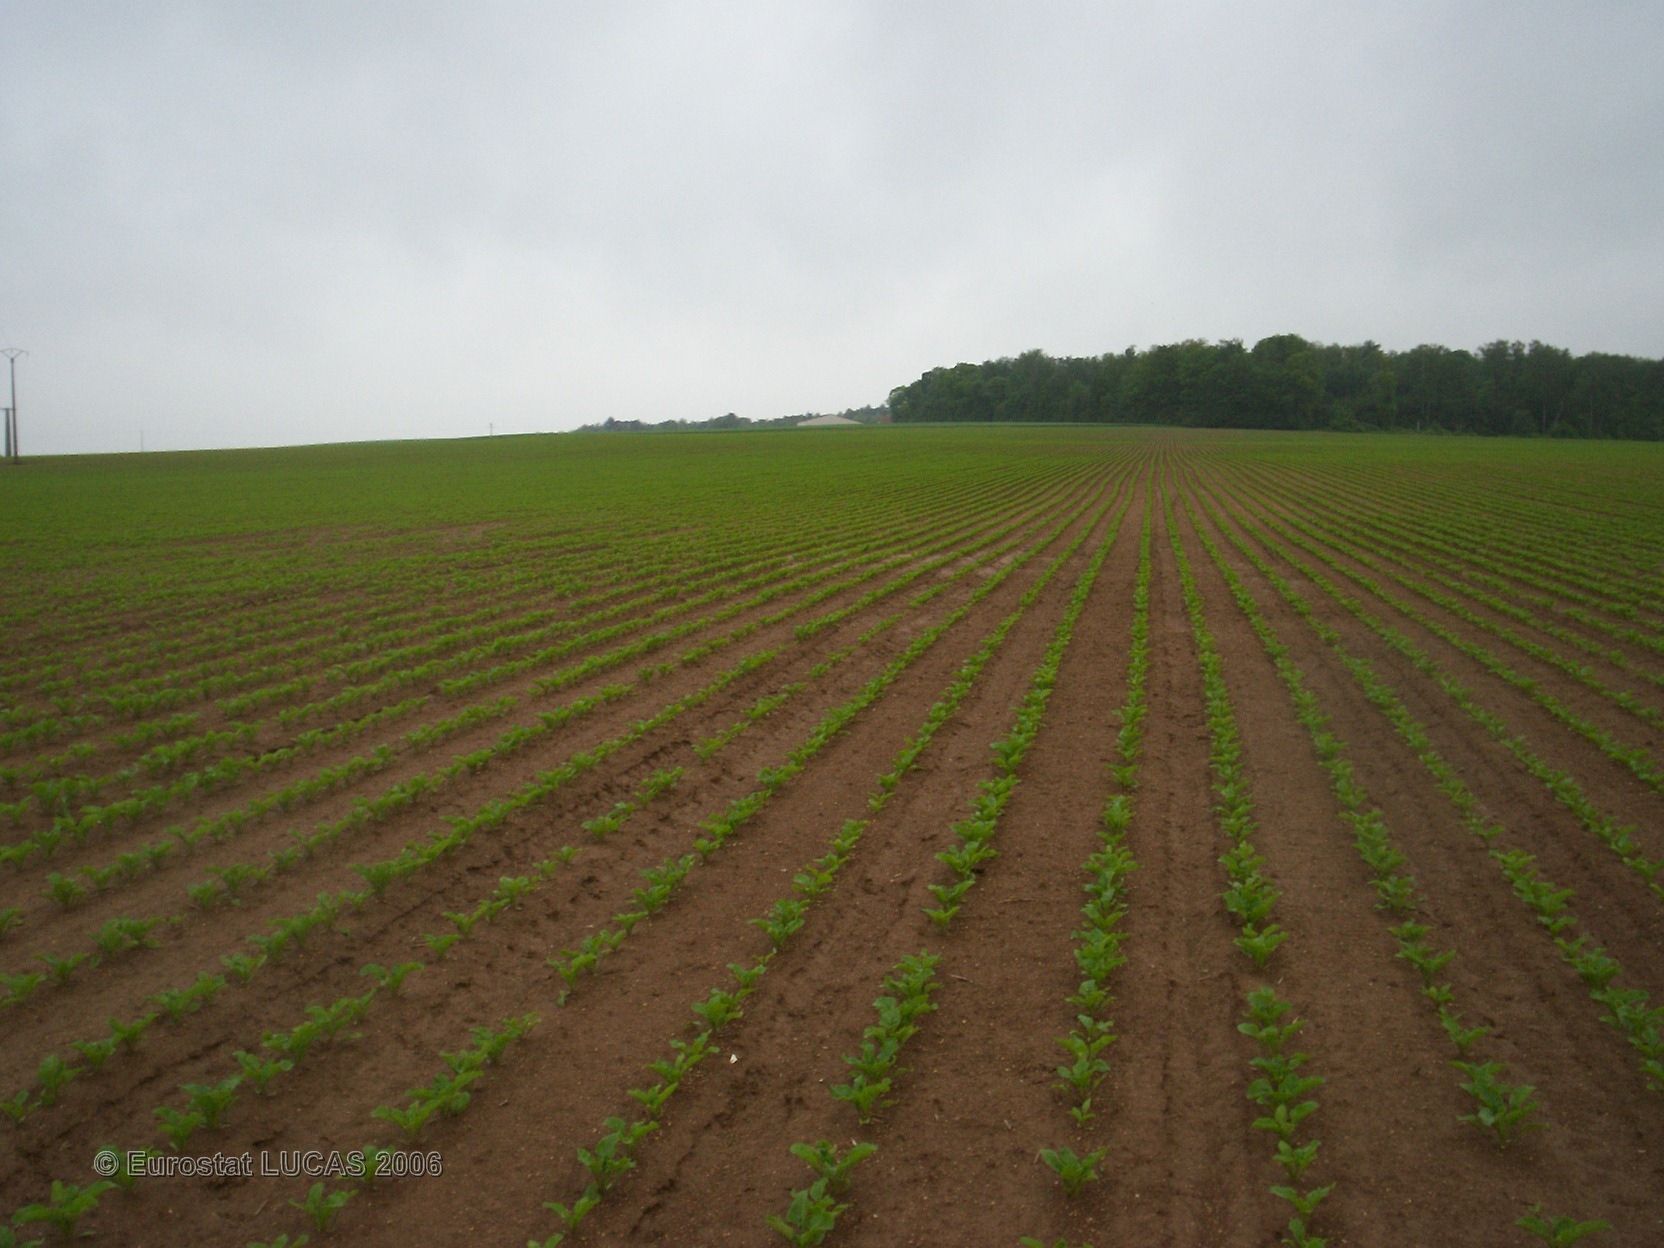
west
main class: Cropland
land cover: Sugar beet
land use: Agriculture (excluding fallow land and kitchen gardens)
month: May
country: FR
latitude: 49.4150
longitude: 4.3859
